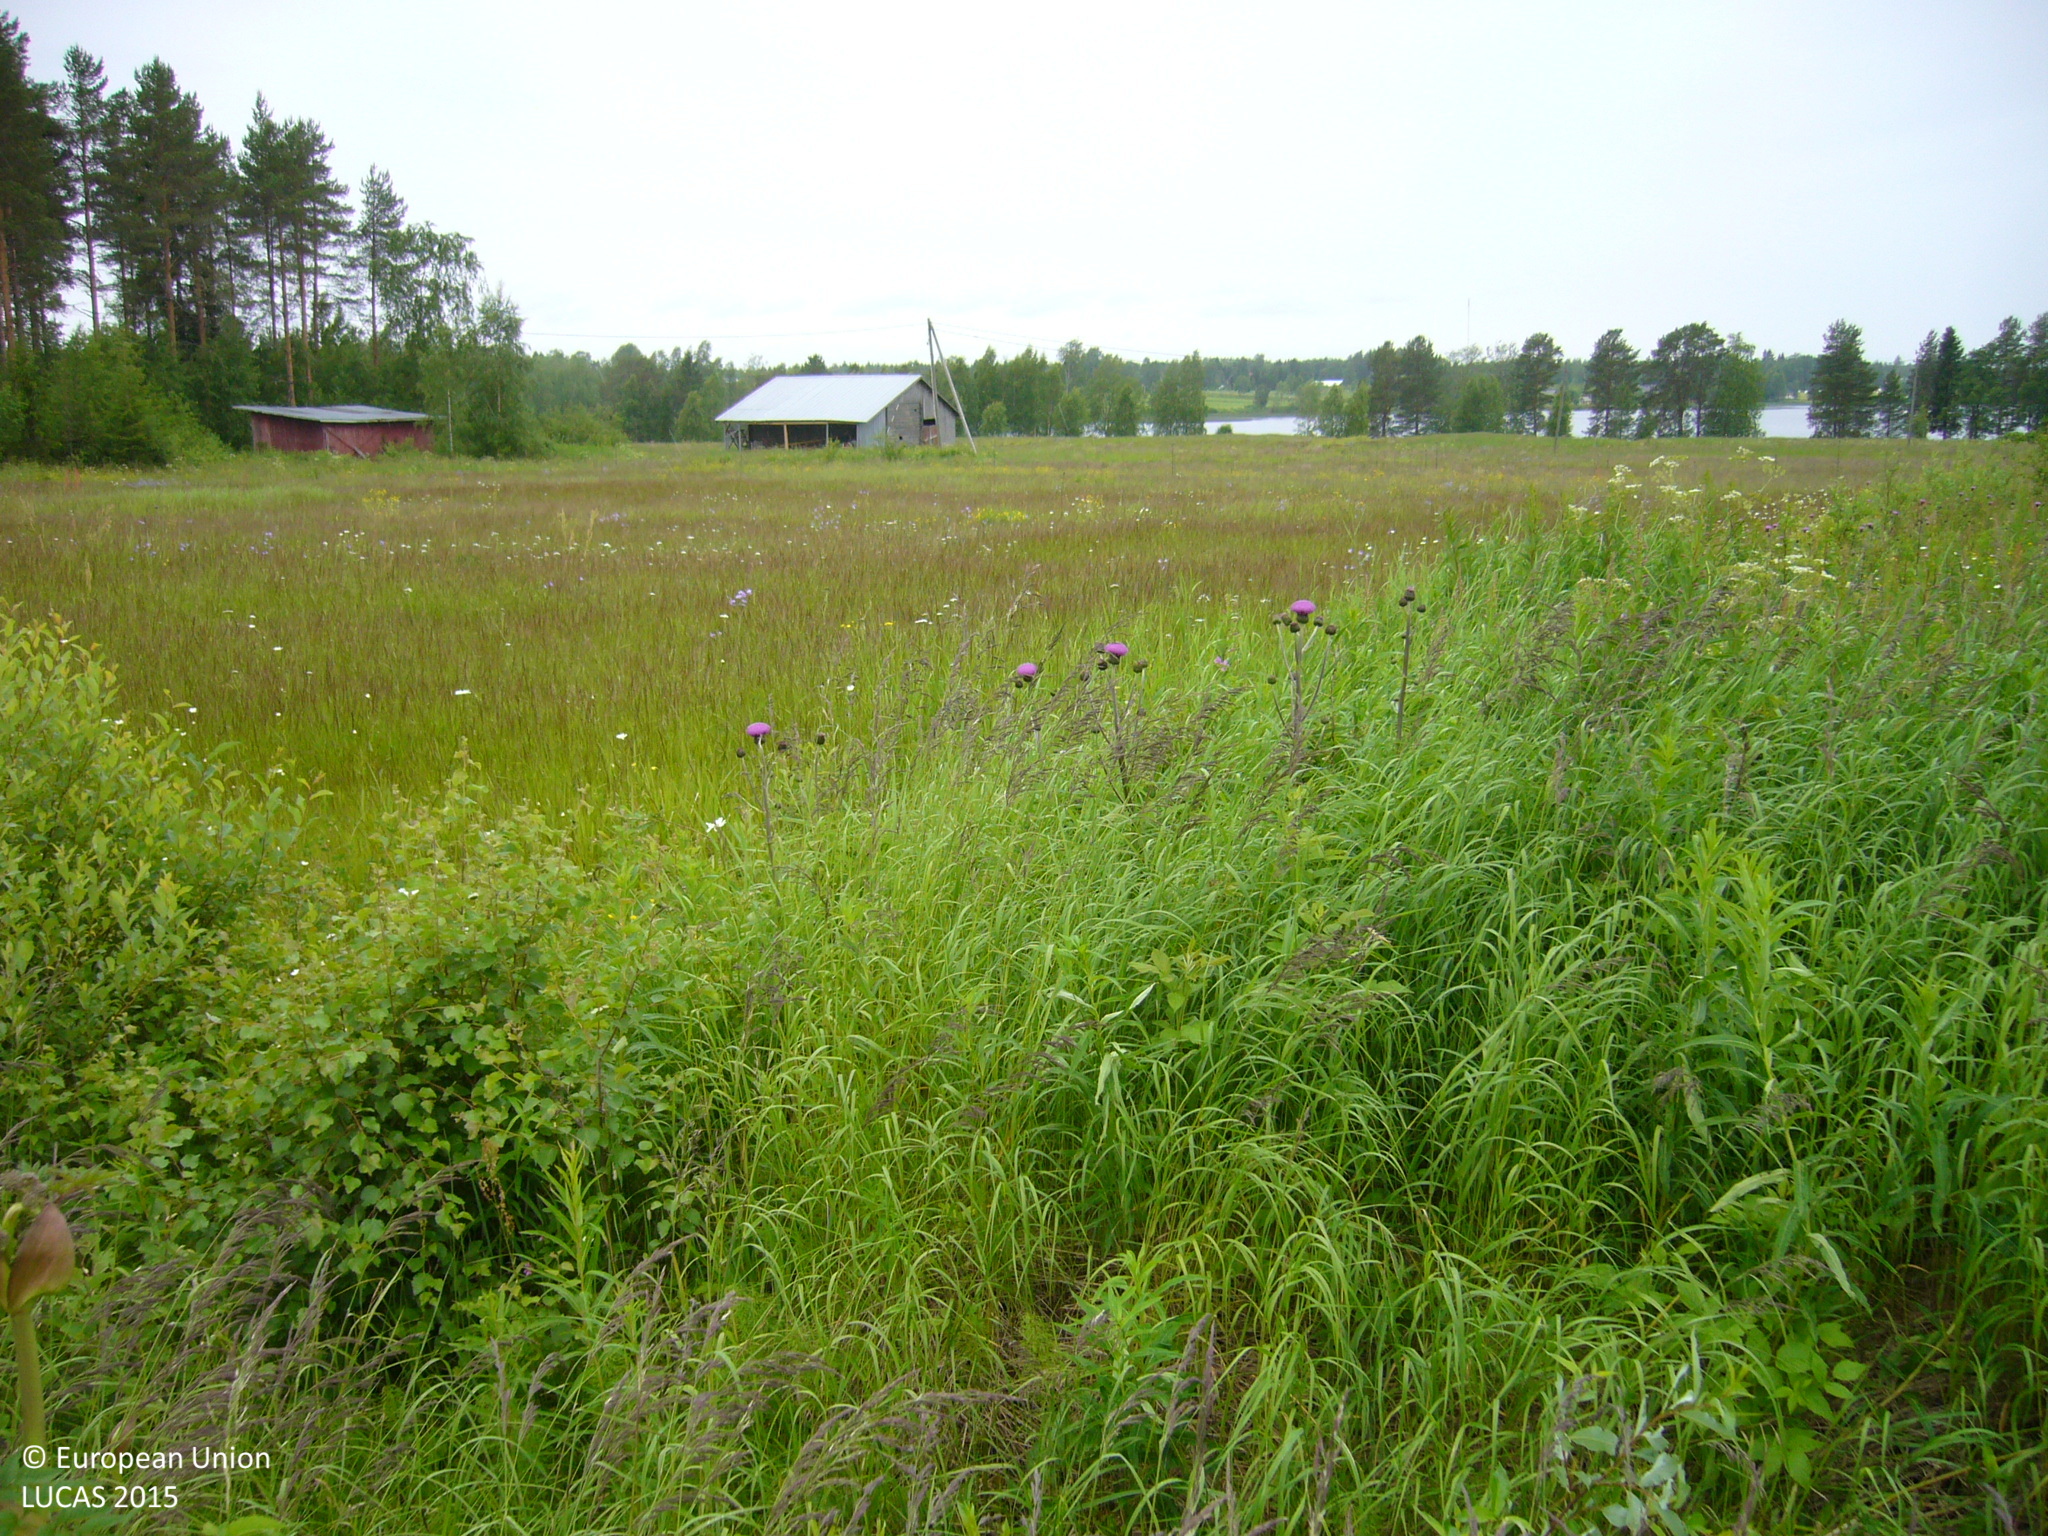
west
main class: Grassland
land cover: Grassland without tree/shrub cover
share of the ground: > 75 %
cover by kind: herbaceous plants 100 %
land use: Agriculture (excluding fallow land and kitchen gardens)
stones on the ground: < 10 %
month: July
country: FI
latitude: 63.4581
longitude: 25.7329
